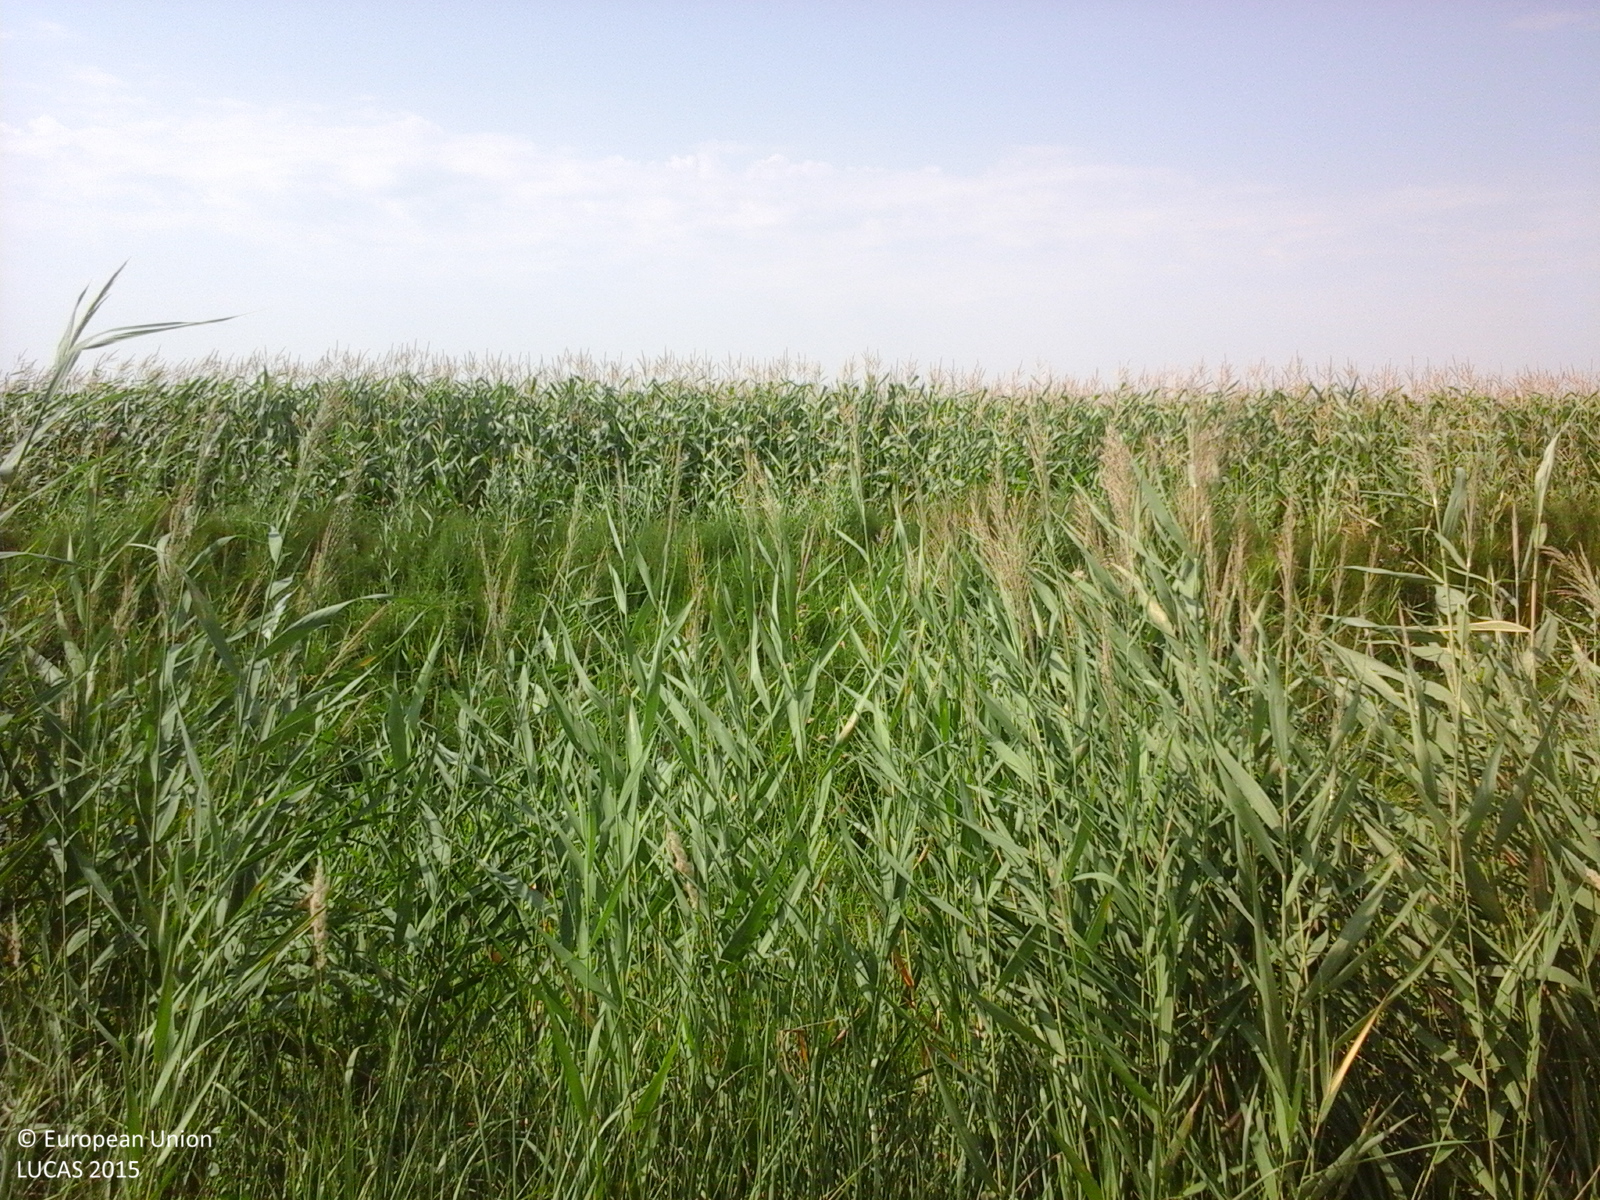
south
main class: Cropland
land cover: Sunflower
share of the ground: > 75 %
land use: Agriculture (excluding fallow land and kitchen gardens)
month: July
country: RO
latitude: 44.6813
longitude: 27.2321
